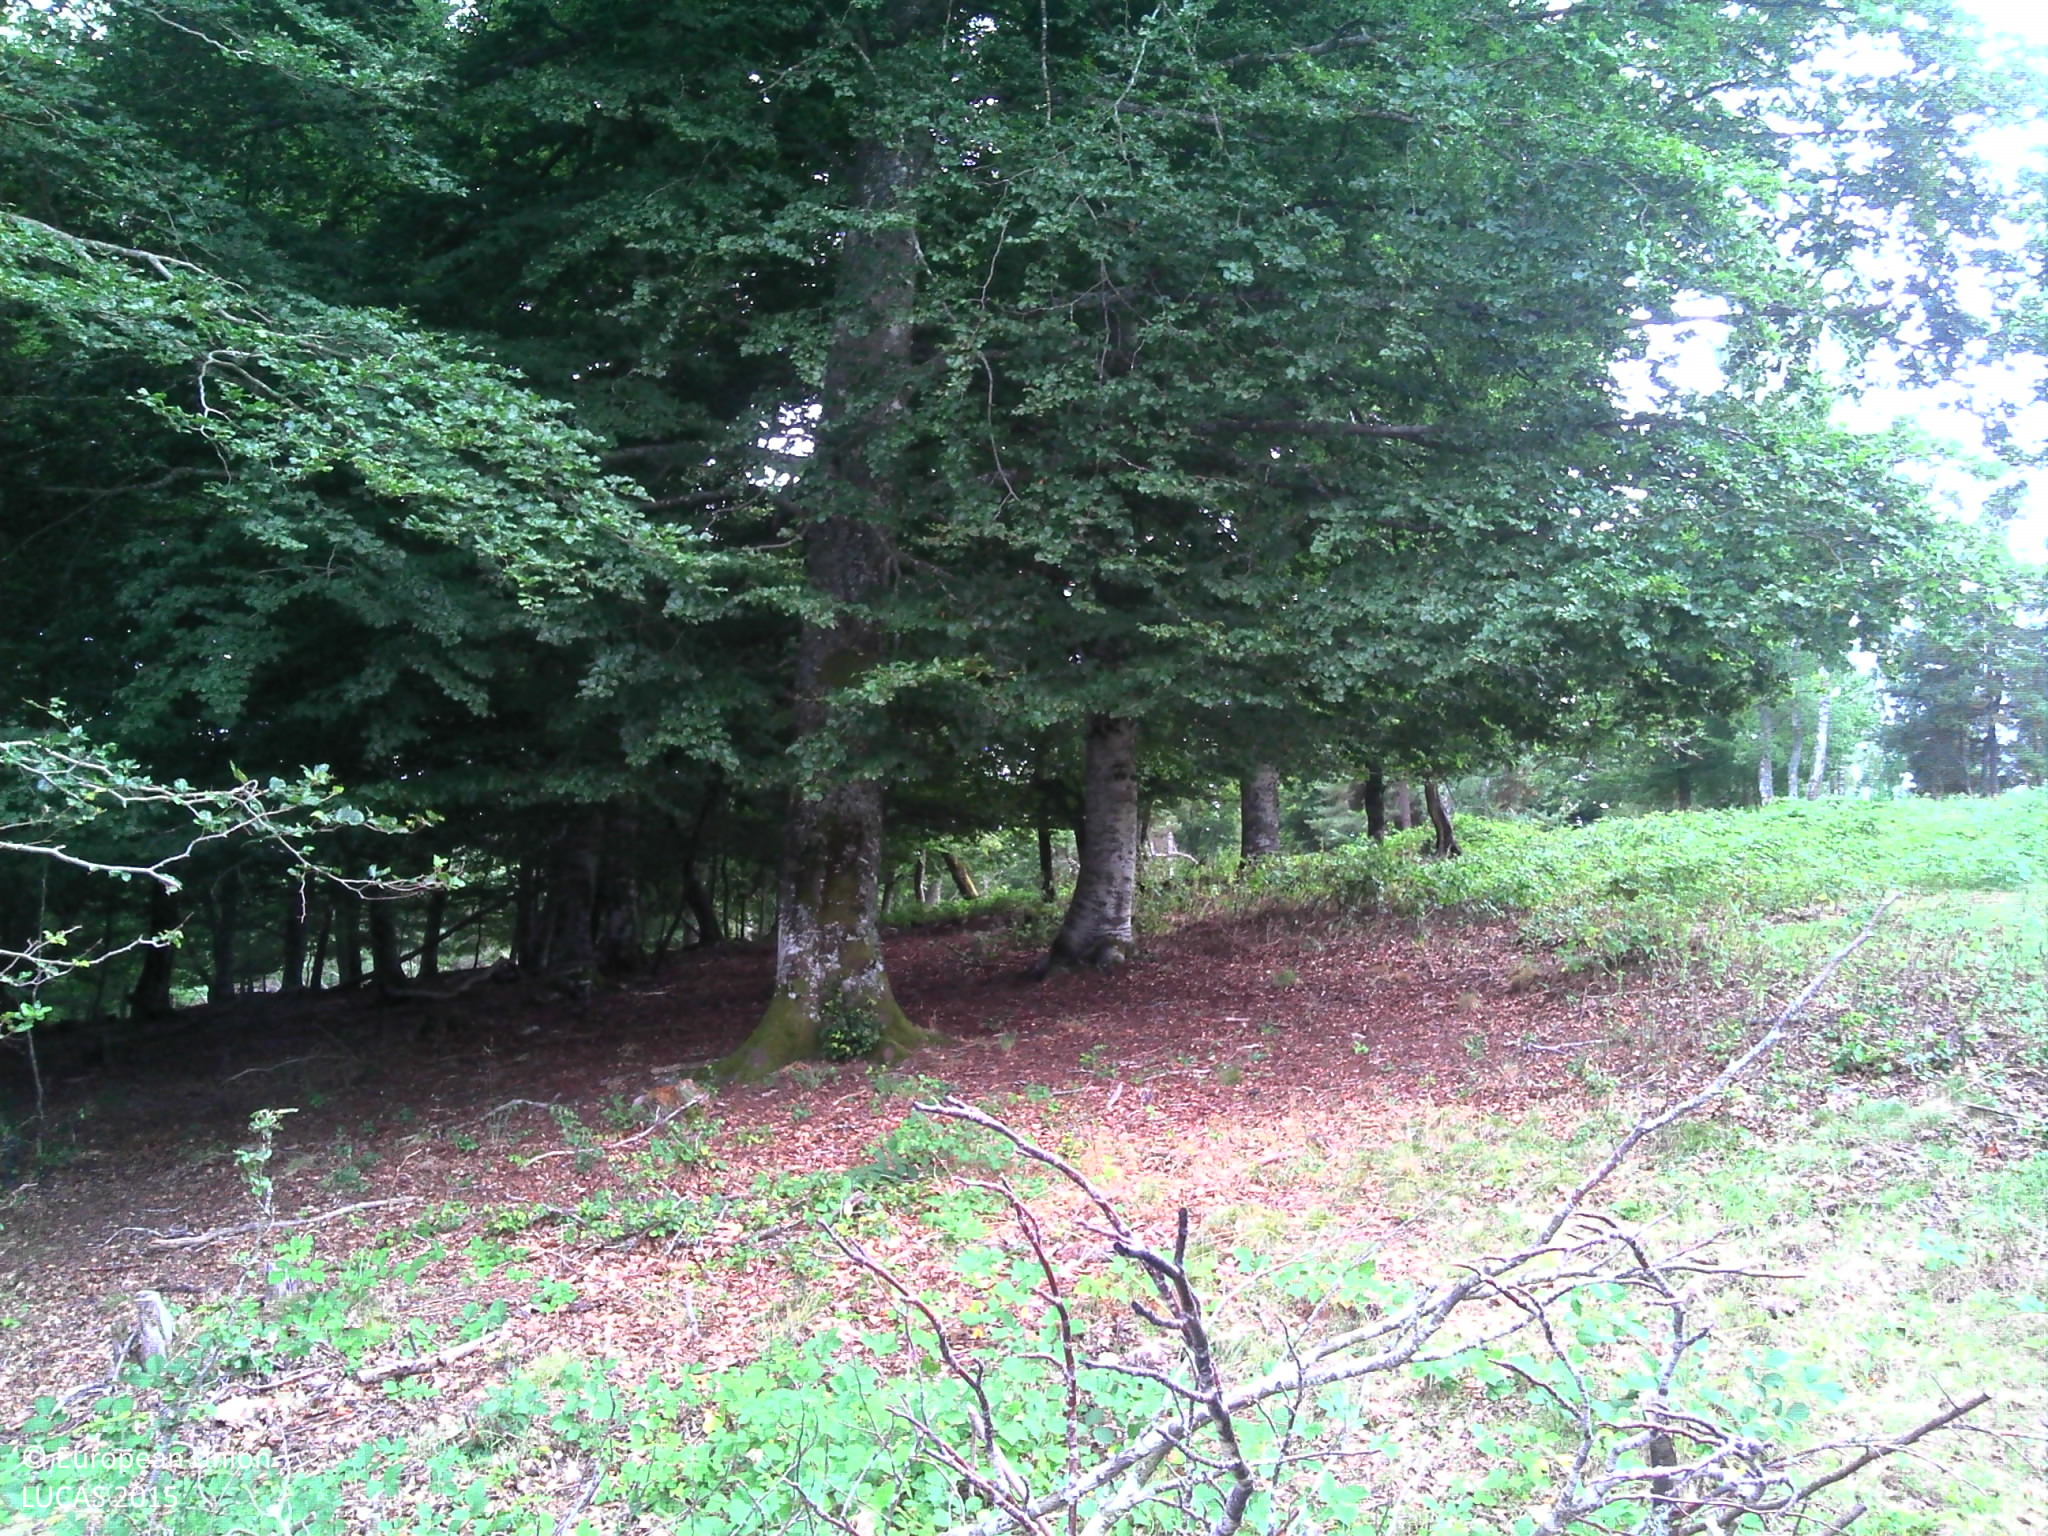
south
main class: Grassland
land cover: Grassland with sparse tree/shrub cover
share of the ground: > 75 %
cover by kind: herbaceous plants 85 %, shrubs 10 %, broadleaved forest trees 5 %
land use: Agriculture (excluding fallow land and kitchen gardens)
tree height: < 5 m
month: July
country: FR
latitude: 44.8842
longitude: 3.1537
